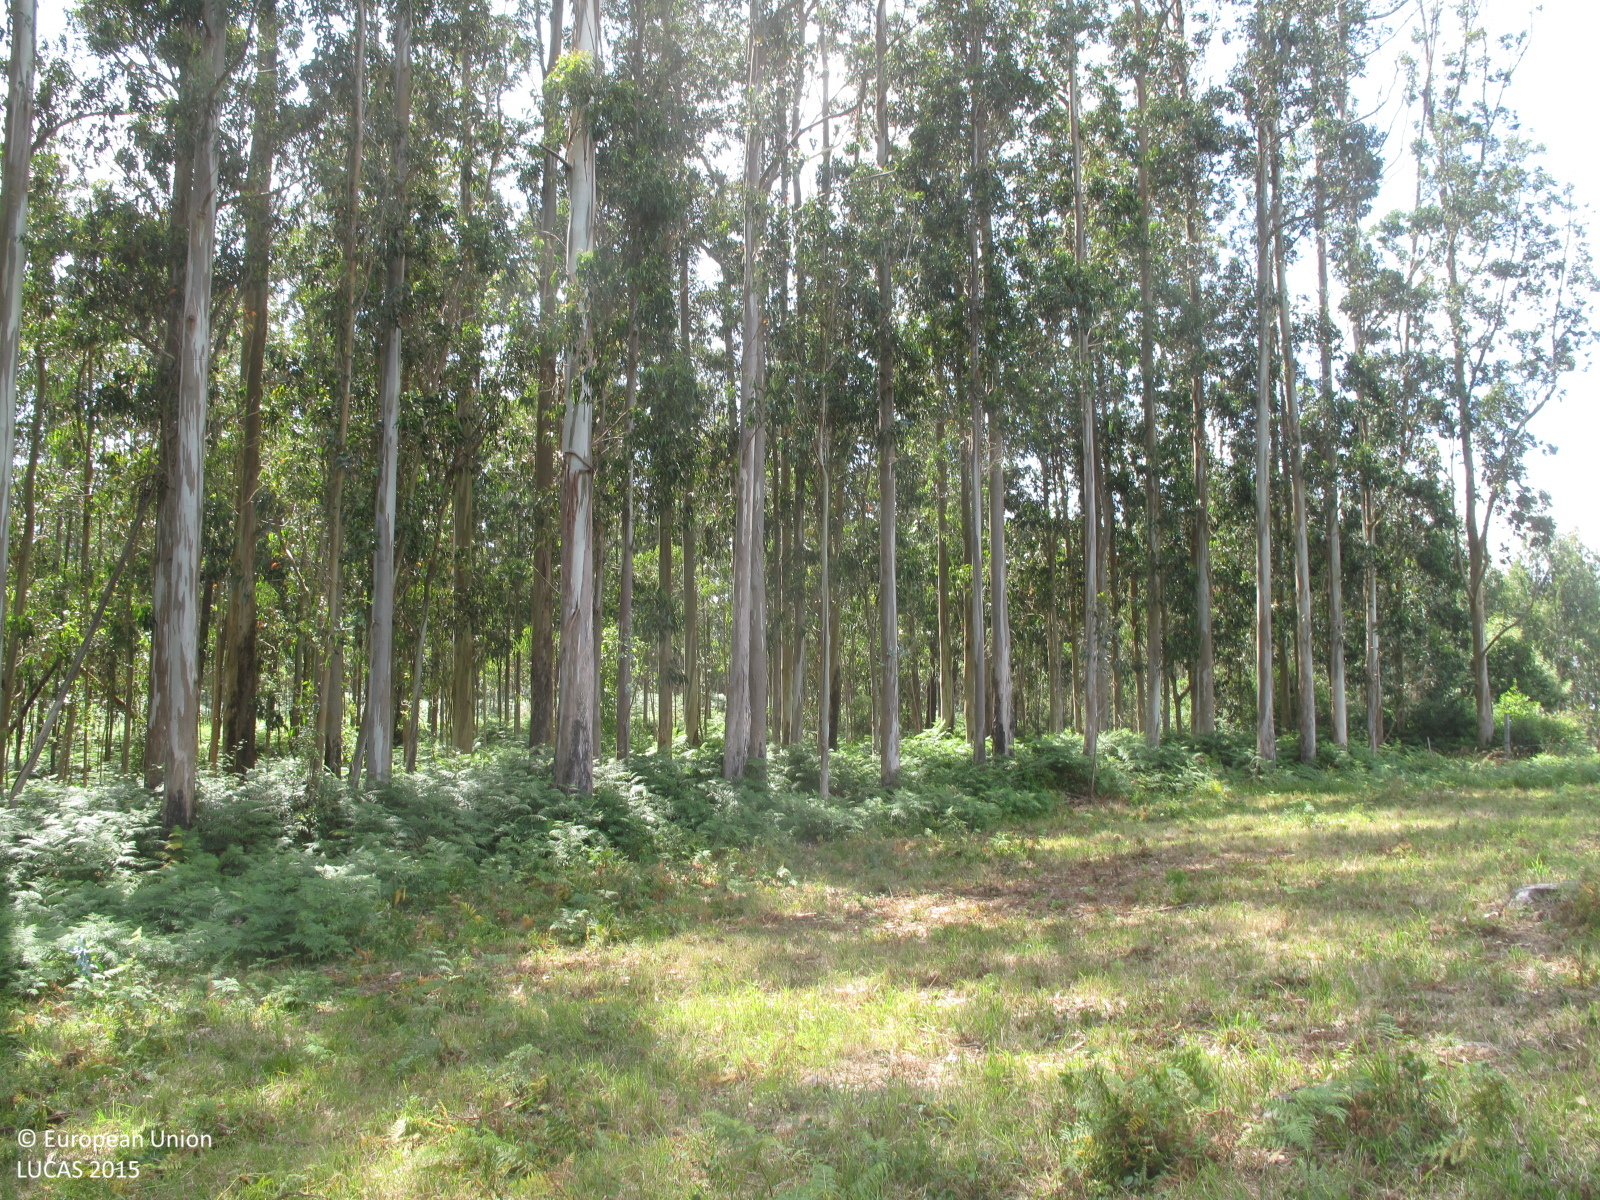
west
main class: Woodland
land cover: Broadleaved woodland
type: exotic forest
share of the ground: 50 - 75 %
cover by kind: broadleaved forest trees 50 %, herbaceous plants 30 %, shrubs 20 %
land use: Forestry
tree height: > 5 m
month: July
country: ES
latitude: 43.6483
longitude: -8.0899
